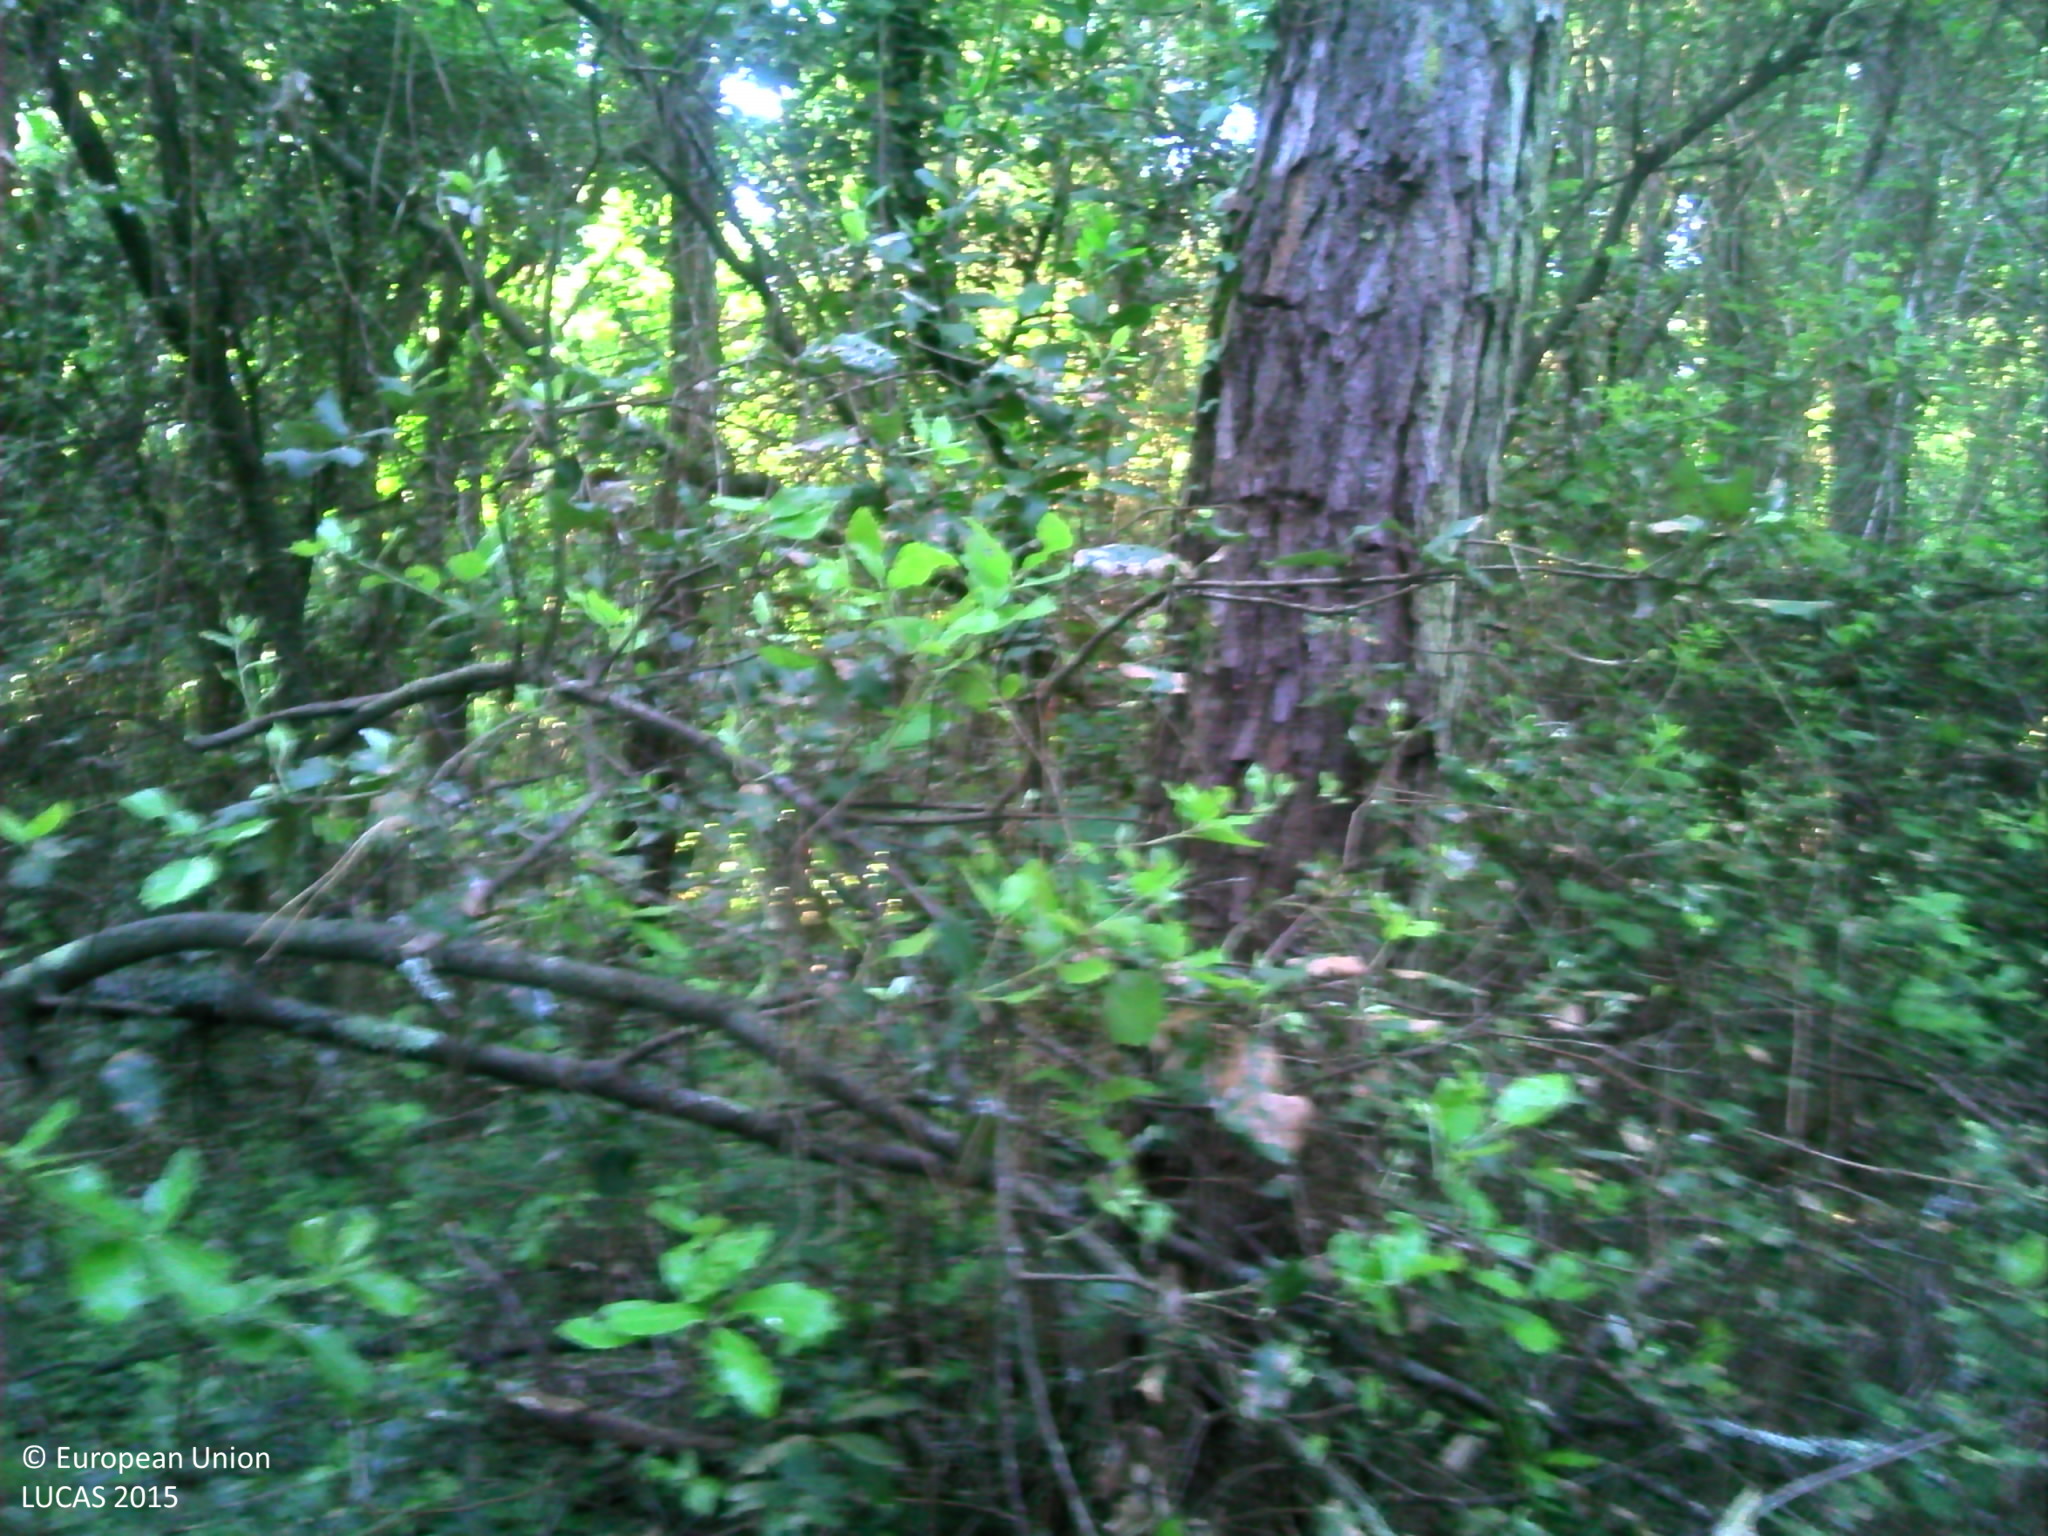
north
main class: Woodland
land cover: Pine dominated mixed woodland
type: coniferous forest of the mediterranean region
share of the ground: > 75 %
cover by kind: coniferous forest trees 75 %, broadleaved forest trees 25 %
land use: Forestry
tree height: > 5 m
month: May
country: FR
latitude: 45.8318
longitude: -1.2179
